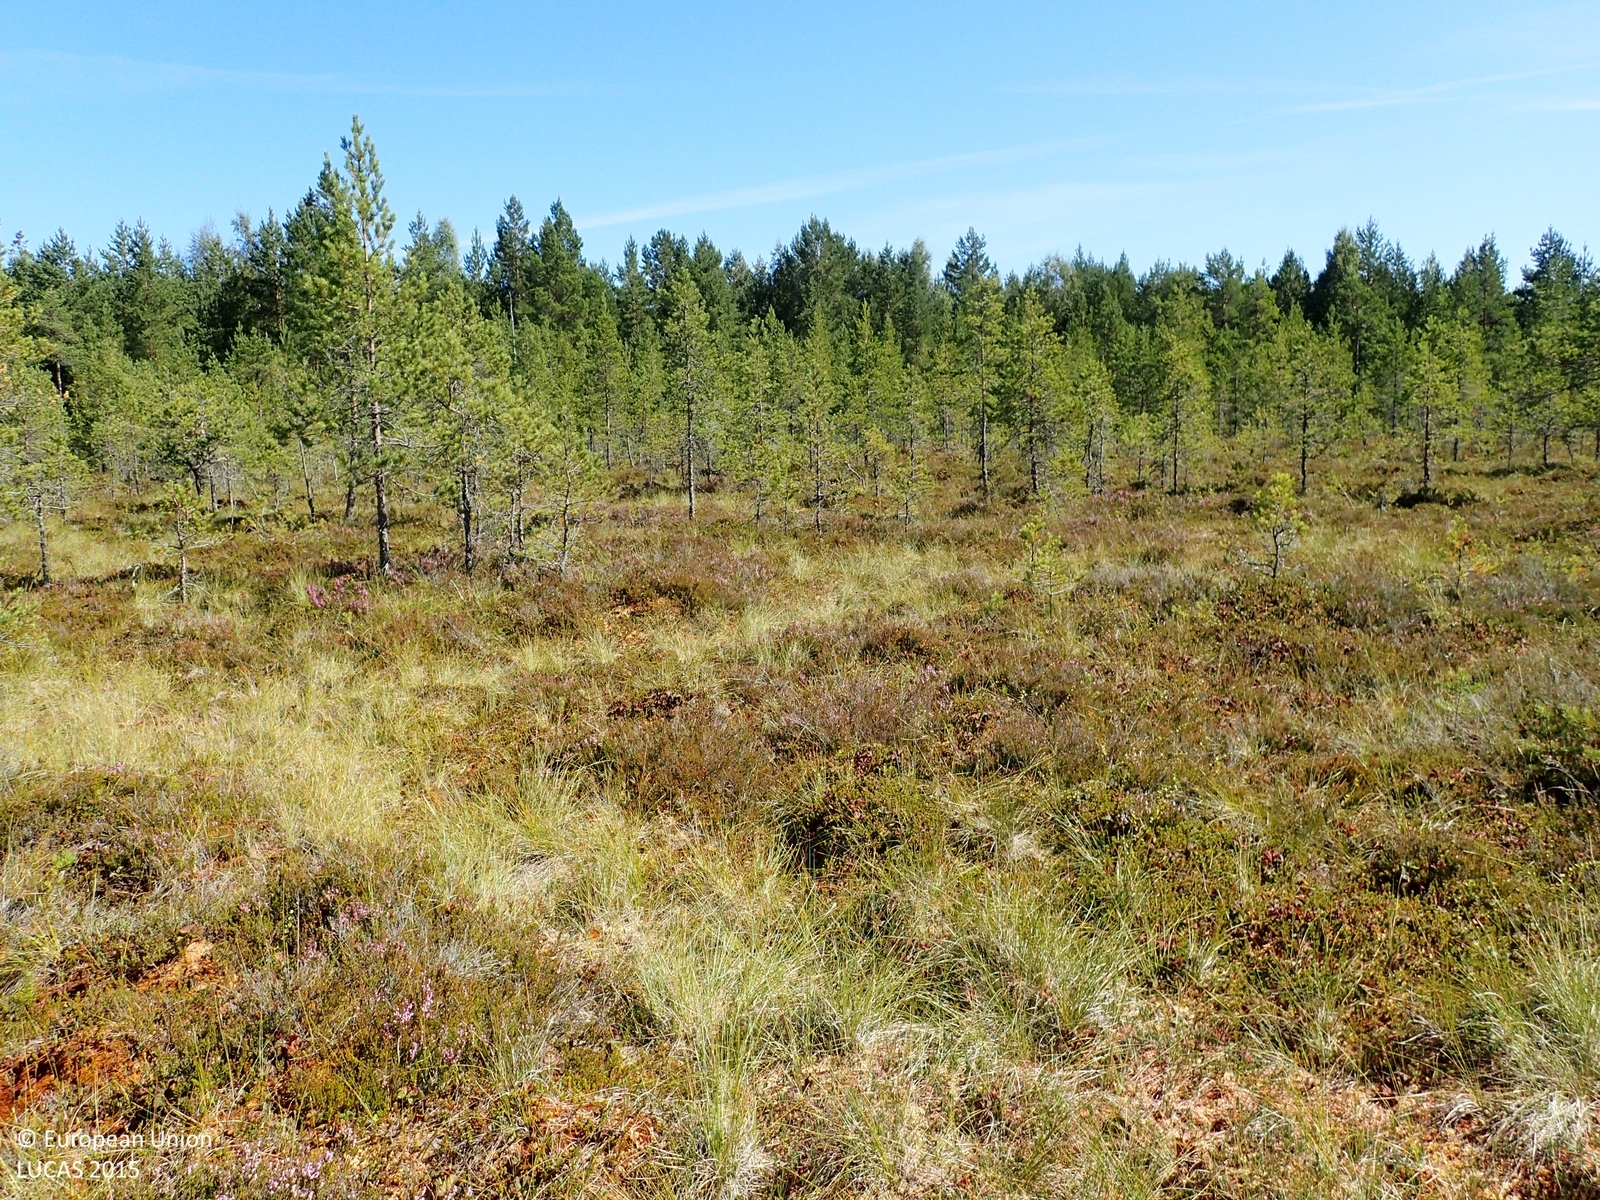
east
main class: Woodland
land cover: Pine dominated coniferous woodland
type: mire and swamp forests
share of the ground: 25 - 50 %
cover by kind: shrubs 50 %, coniferous forest trees 25 %, herbaceous plants 20 %, lichens and mosses 5 %
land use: Amenities, museums, leisure
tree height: < 5 m
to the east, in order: Pine dominated coniferous woodland; Ditches and canals; Abandoned hedges; Tracks; Pine dominated mixed woodland; Ditches and canals; Pine dominated mixed woodland; Ditches and canals; Pine dominated mixed woodland; Ditches and canals; Pine dominated mixed woodland; Ditches and canals; Pine dominated mixed woodland; Ditches and canals; Pine dominated mixed woodland; Spruce dominated mixed woodland
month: August
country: FI
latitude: 62.5065
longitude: 22.5412
